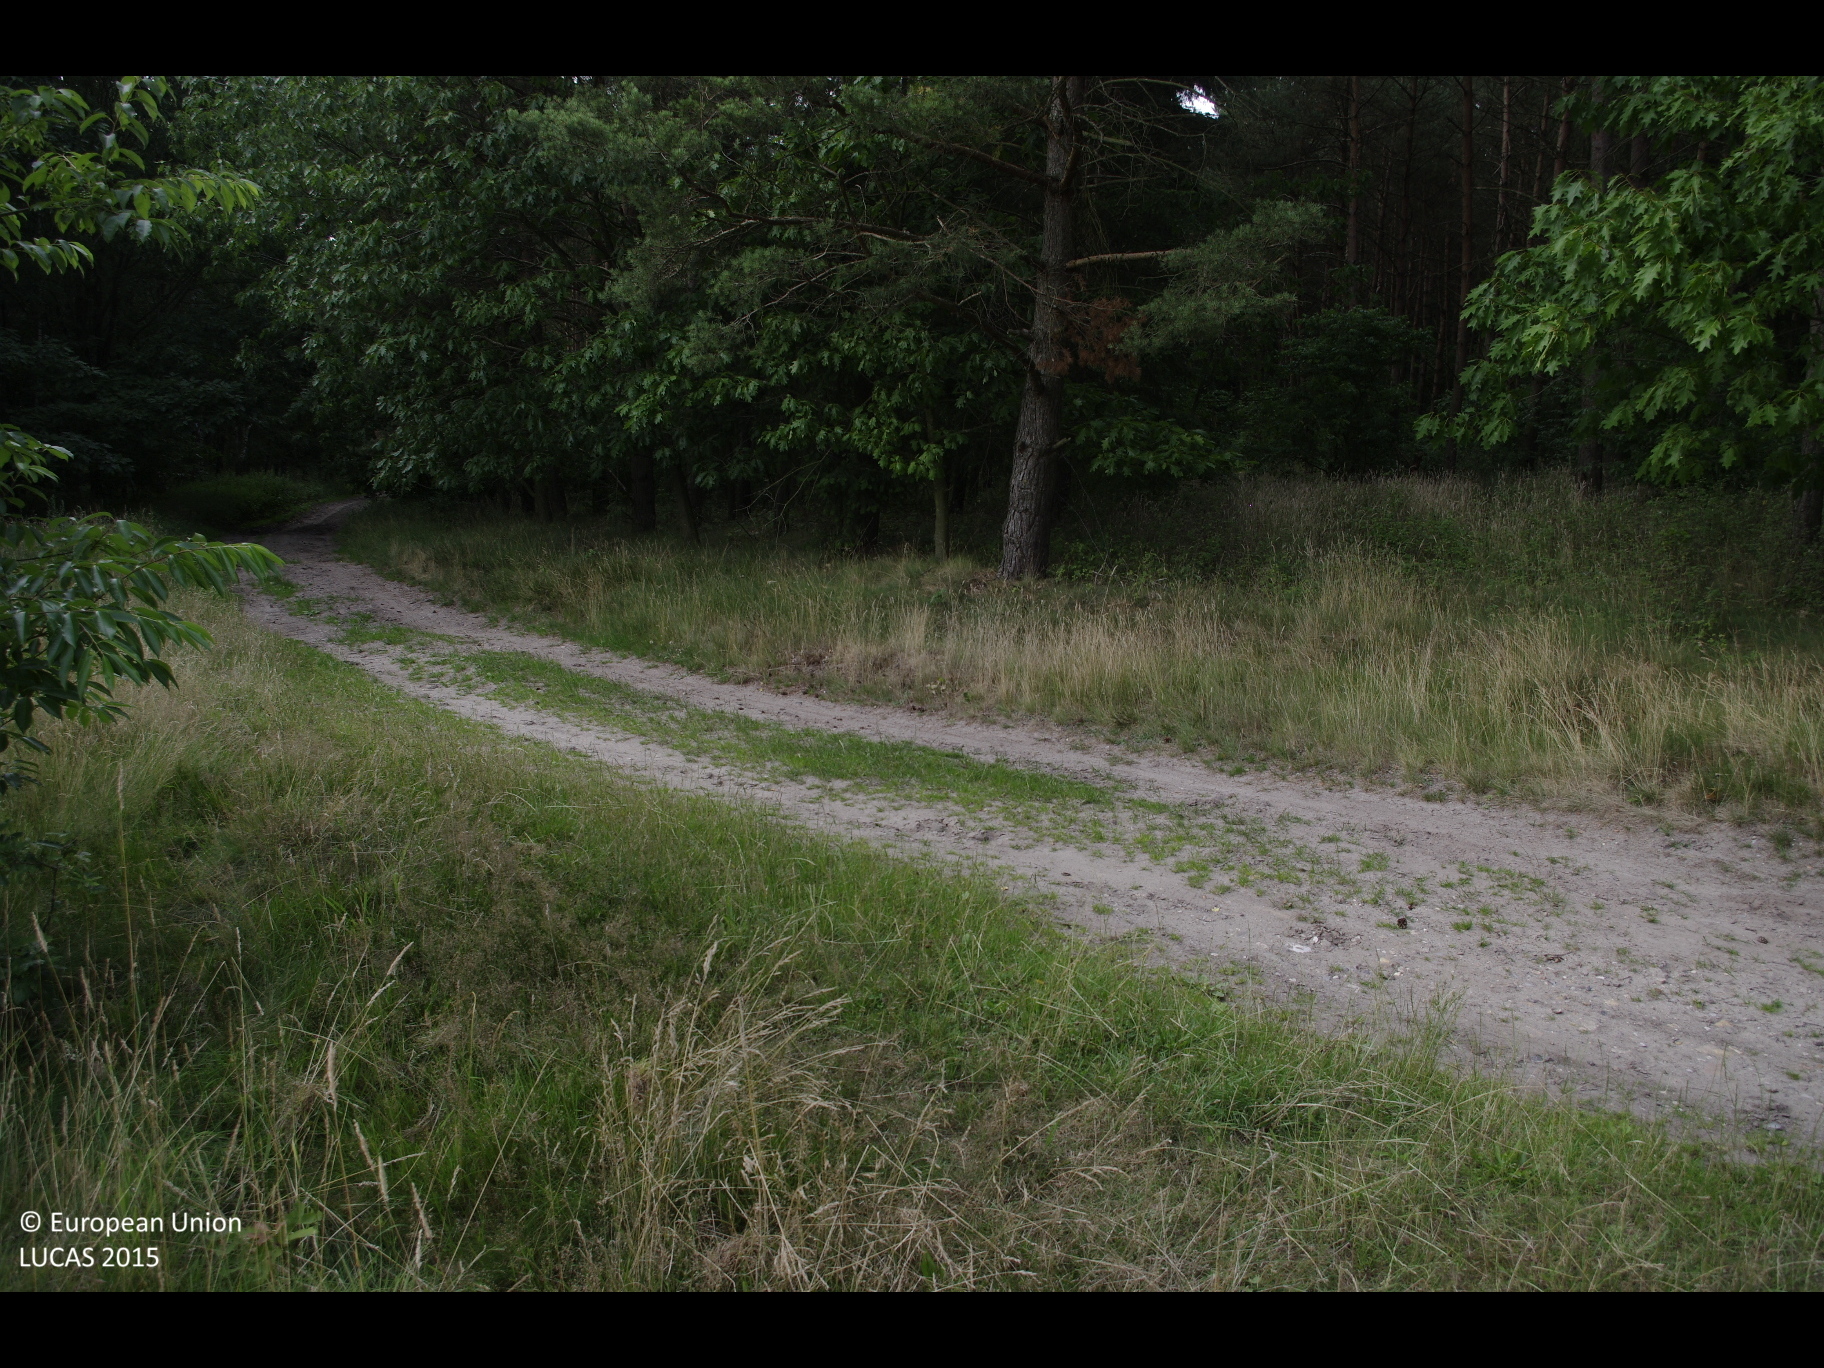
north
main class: Grassland
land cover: Grassland without tree/shrub cover
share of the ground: > 75 %
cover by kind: herbaceous plants 100 %
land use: Agriculture (excluding fallow land and kitchen gardens)
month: July
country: DE
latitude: 53.9411
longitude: 9.9239
